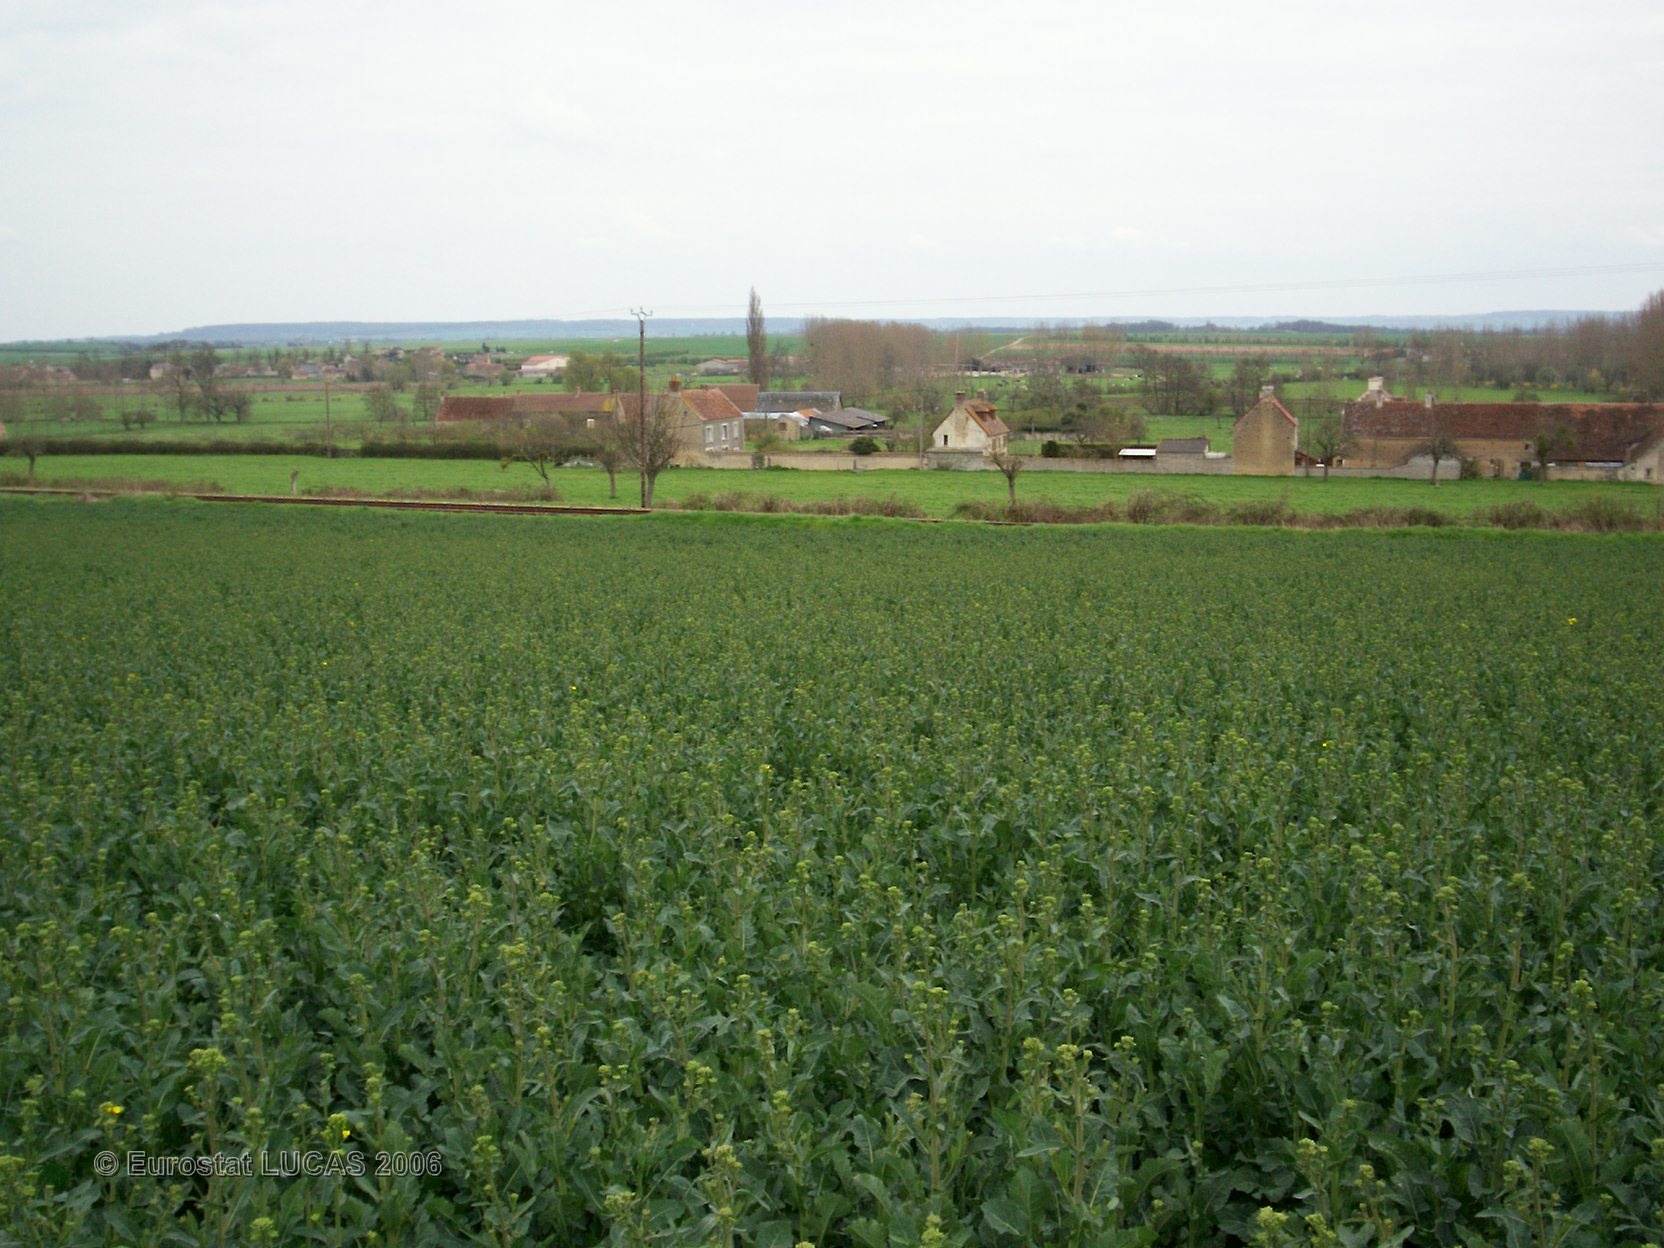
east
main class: Cropland
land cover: Rape and turnip rape
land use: Agriculture (excluding fallow land and kitchen gardens)
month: April
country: FR
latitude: 48.9935
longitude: -0.0768
